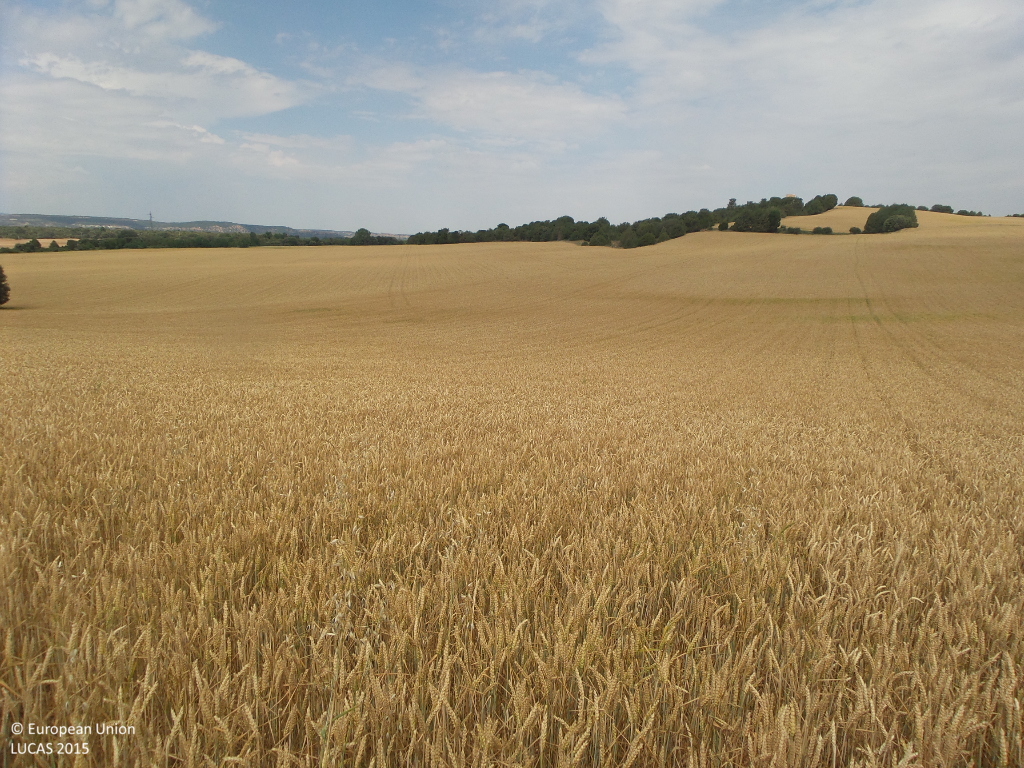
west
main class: Cropland
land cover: Common wheat
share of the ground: > 75 %
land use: Agriculture (excluding fallow land and kitchen gardens)
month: June
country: ES
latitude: 41.5321
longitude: -3.0466
